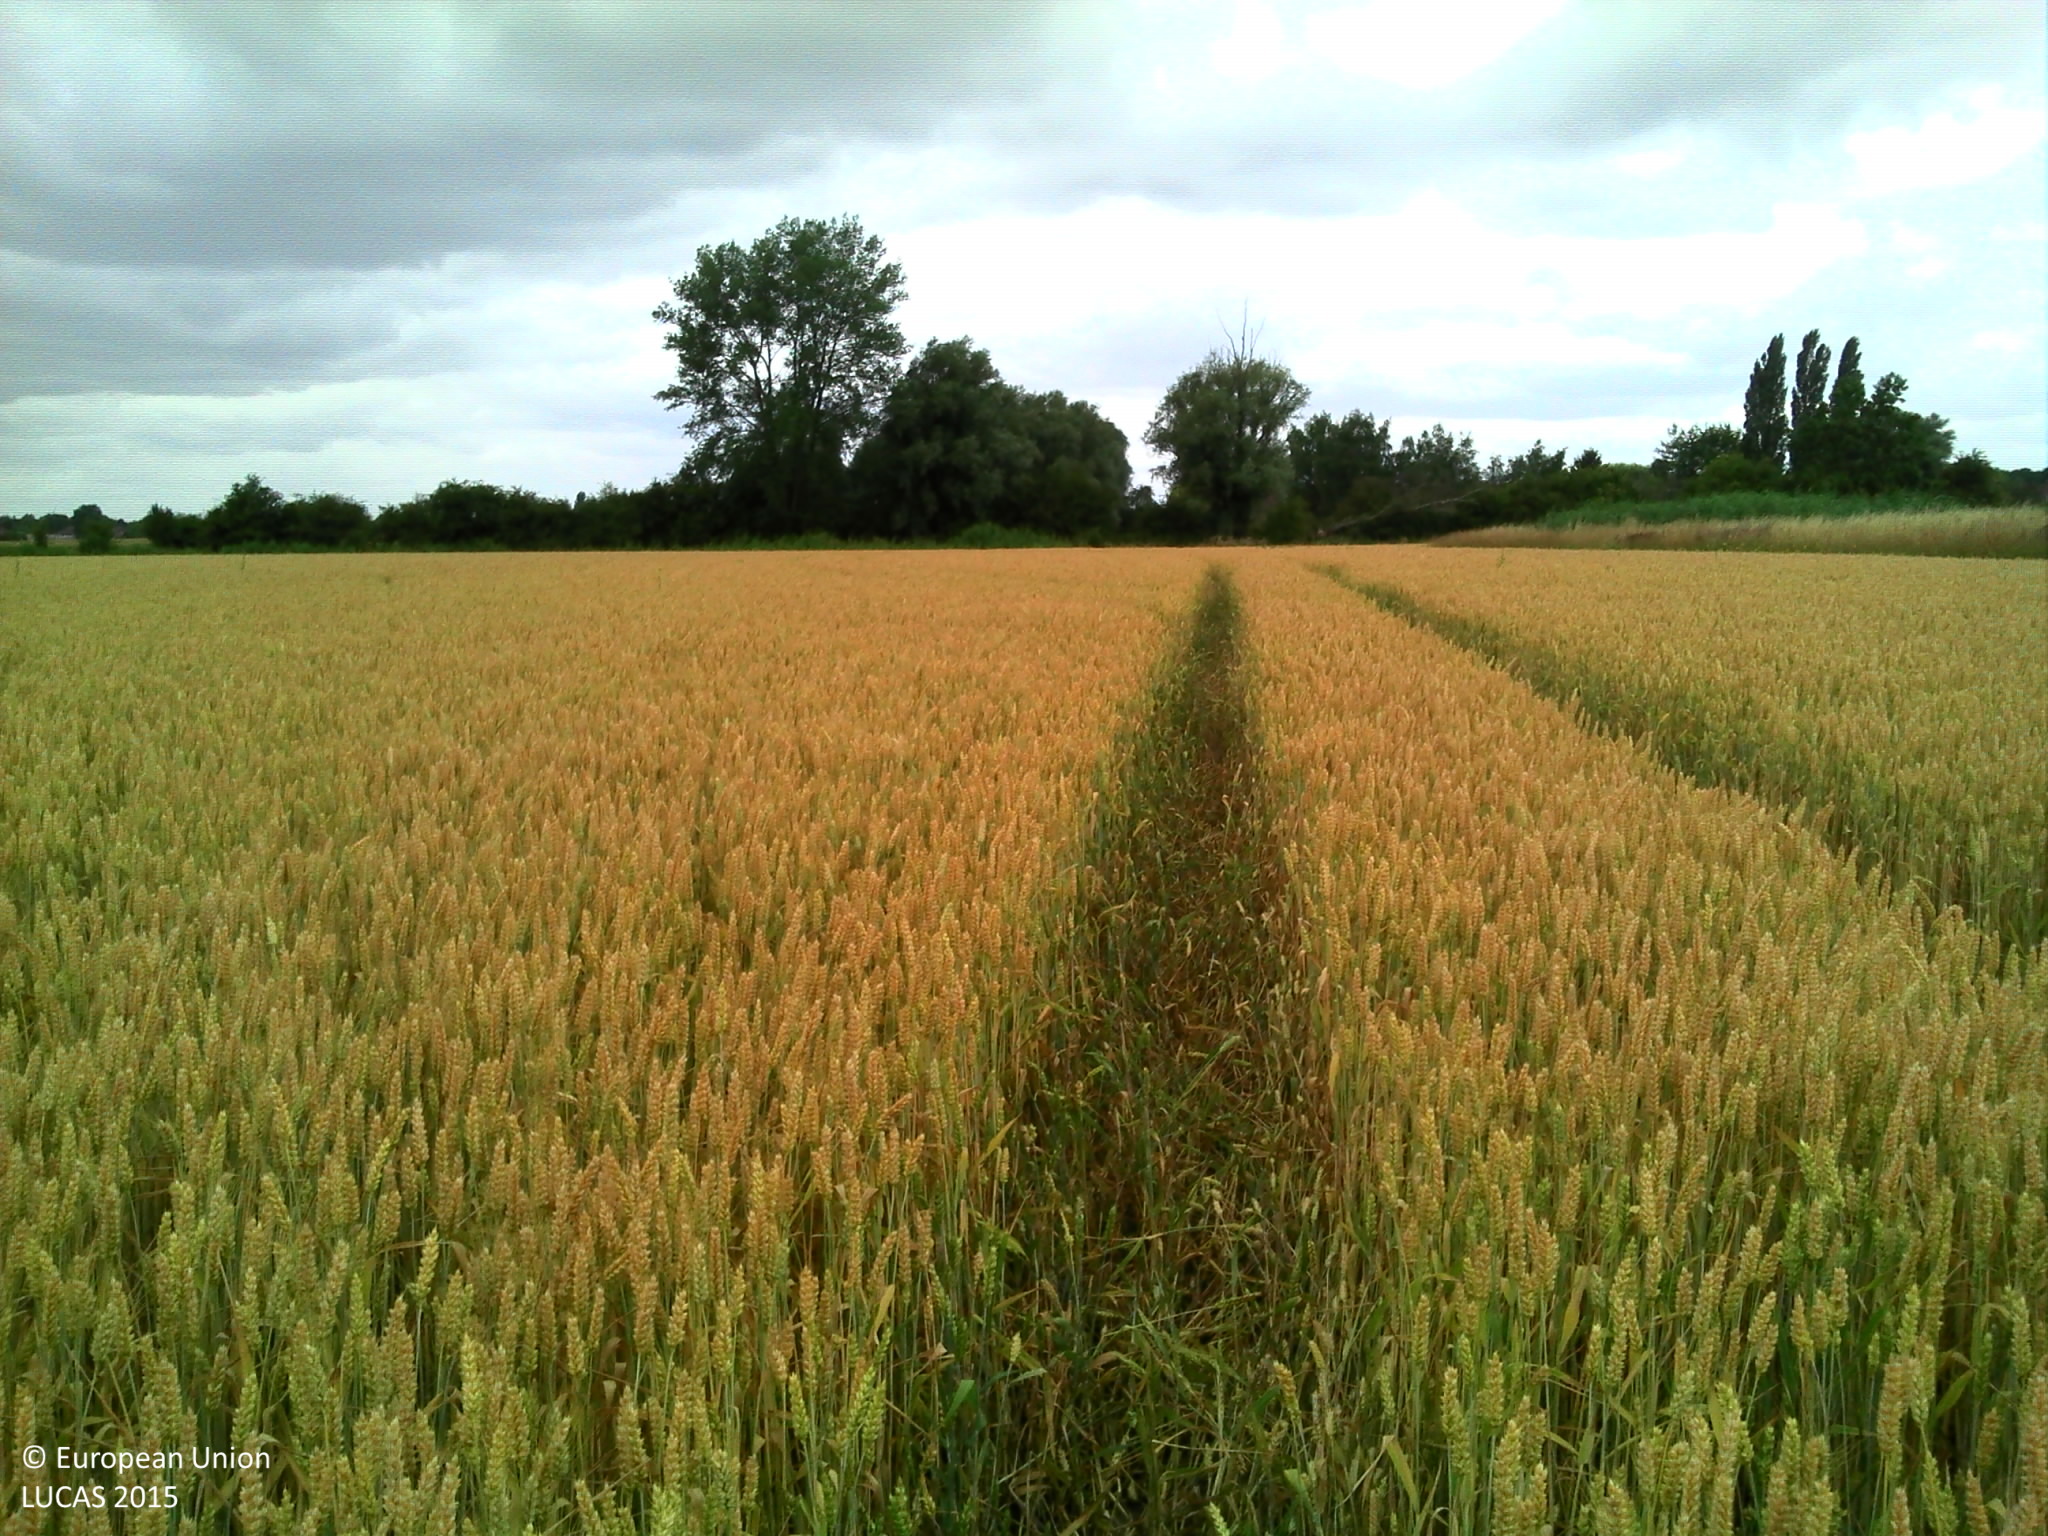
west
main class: Cropland
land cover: Common wheat
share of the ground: > 75 %
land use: Agriculture (excluding fallow land and kitchen gardens)
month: July
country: FR
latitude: 50.4251
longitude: 3.0791
